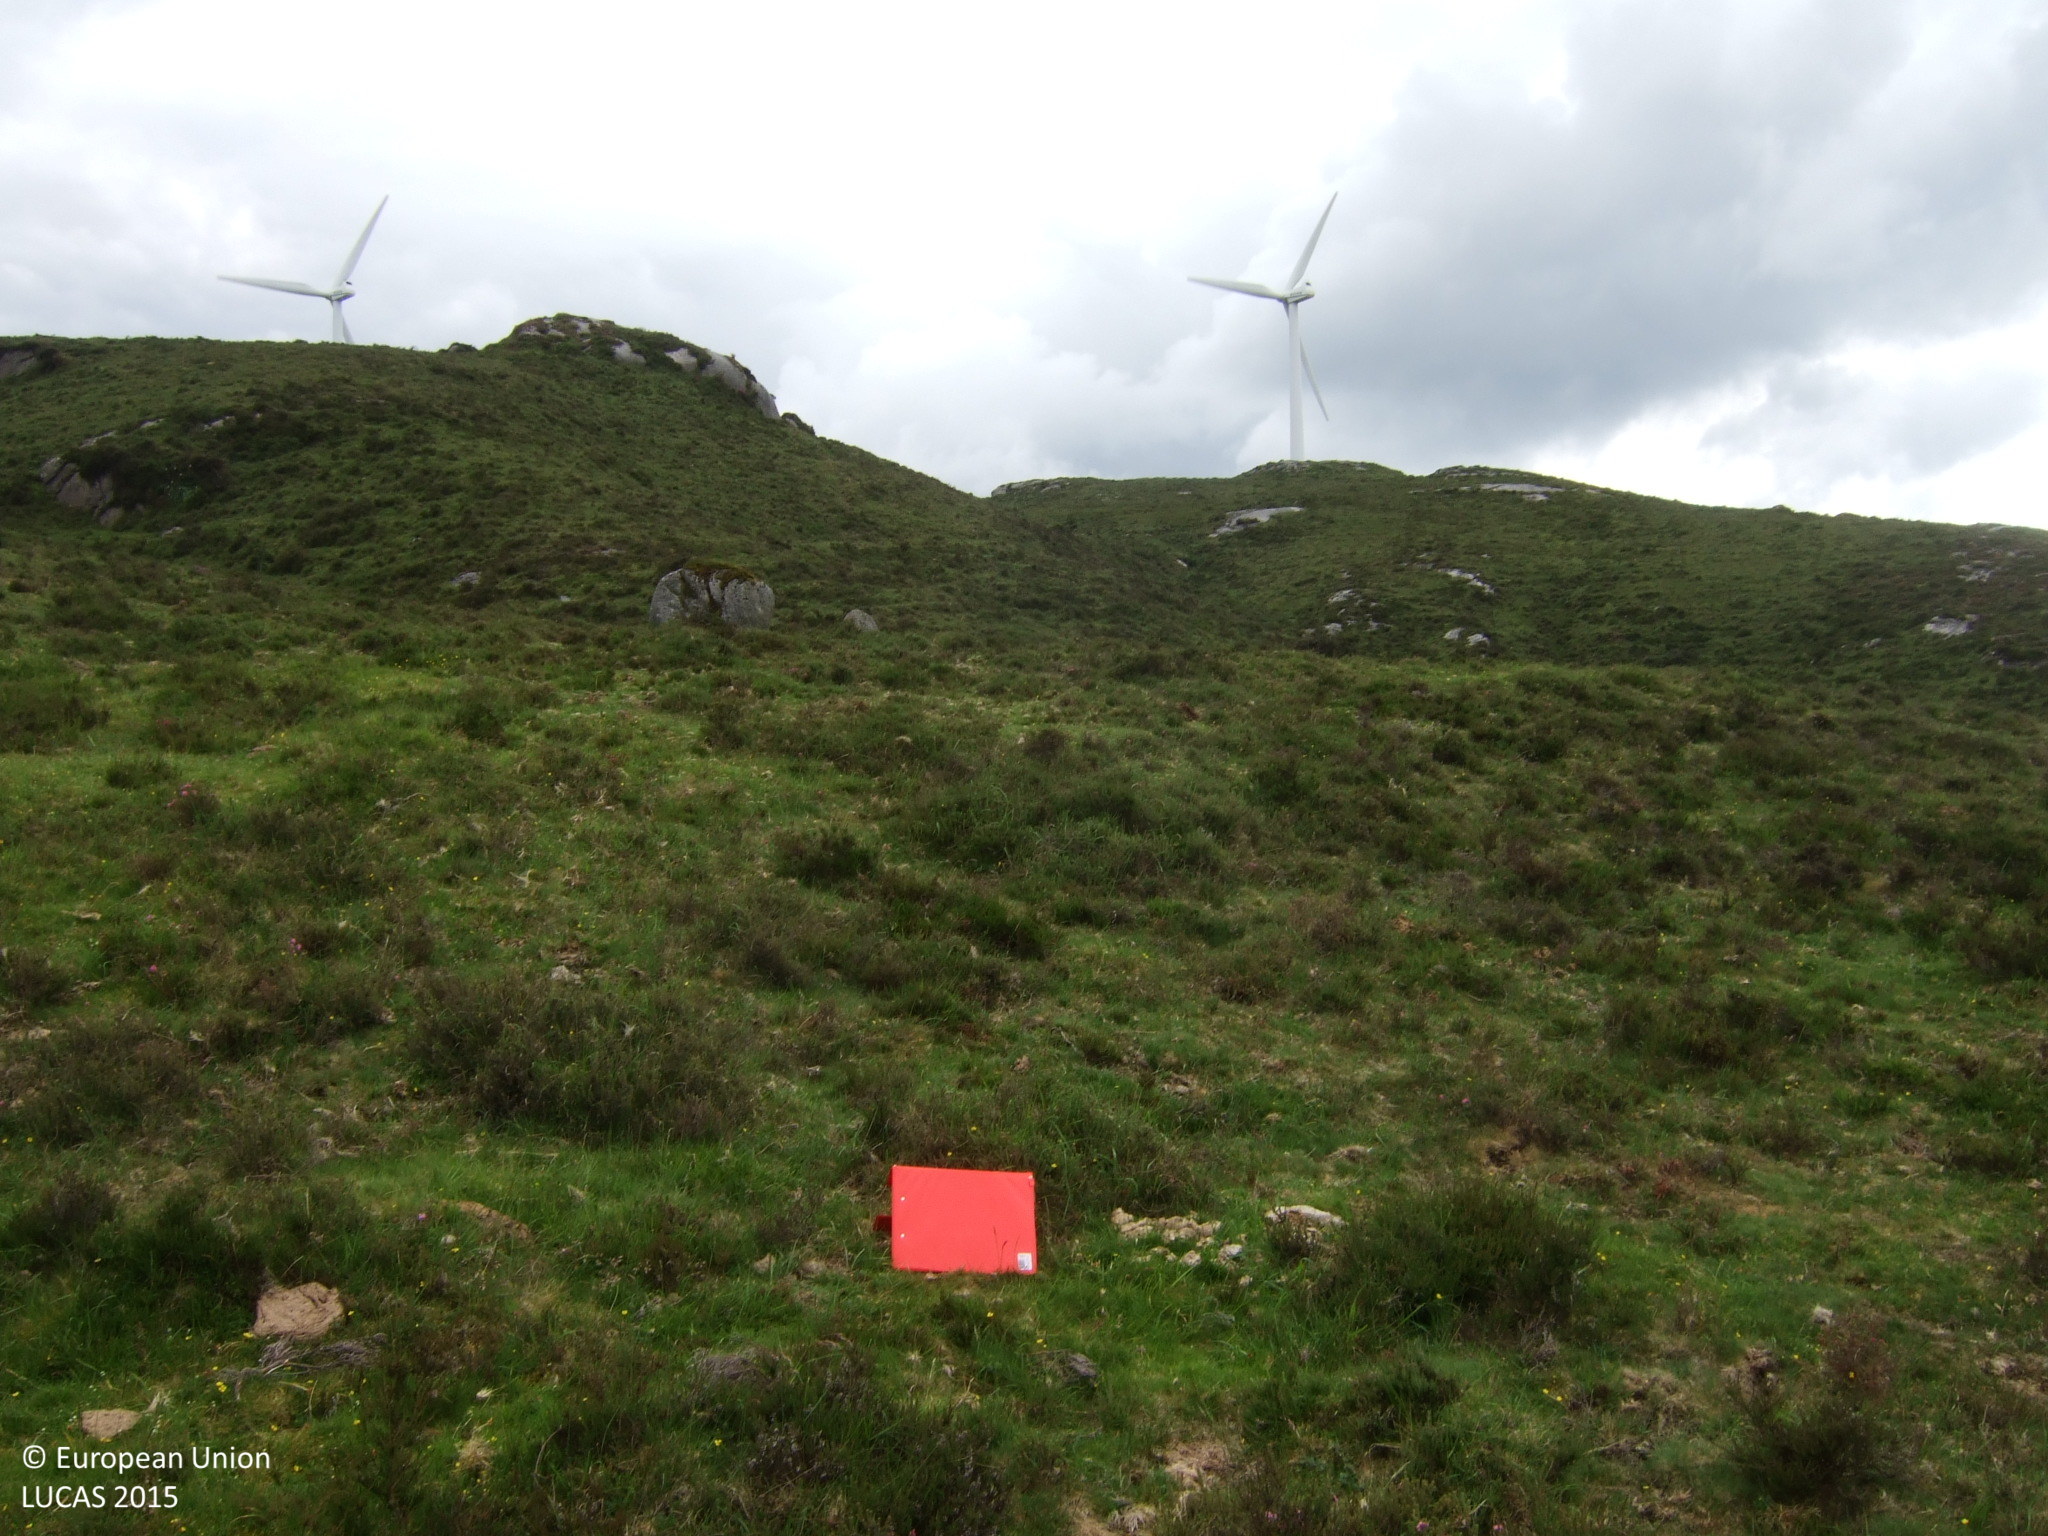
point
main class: Shrubland
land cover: Shrubland without tree cover
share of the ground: 25 - 50 %
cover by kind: herbaceous plants 60 %, shrubs 40 %
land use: Agriculture (excluding fallow land and kitchen gardens)
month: June
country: ES
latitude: 43.4581
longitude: -7.4947
